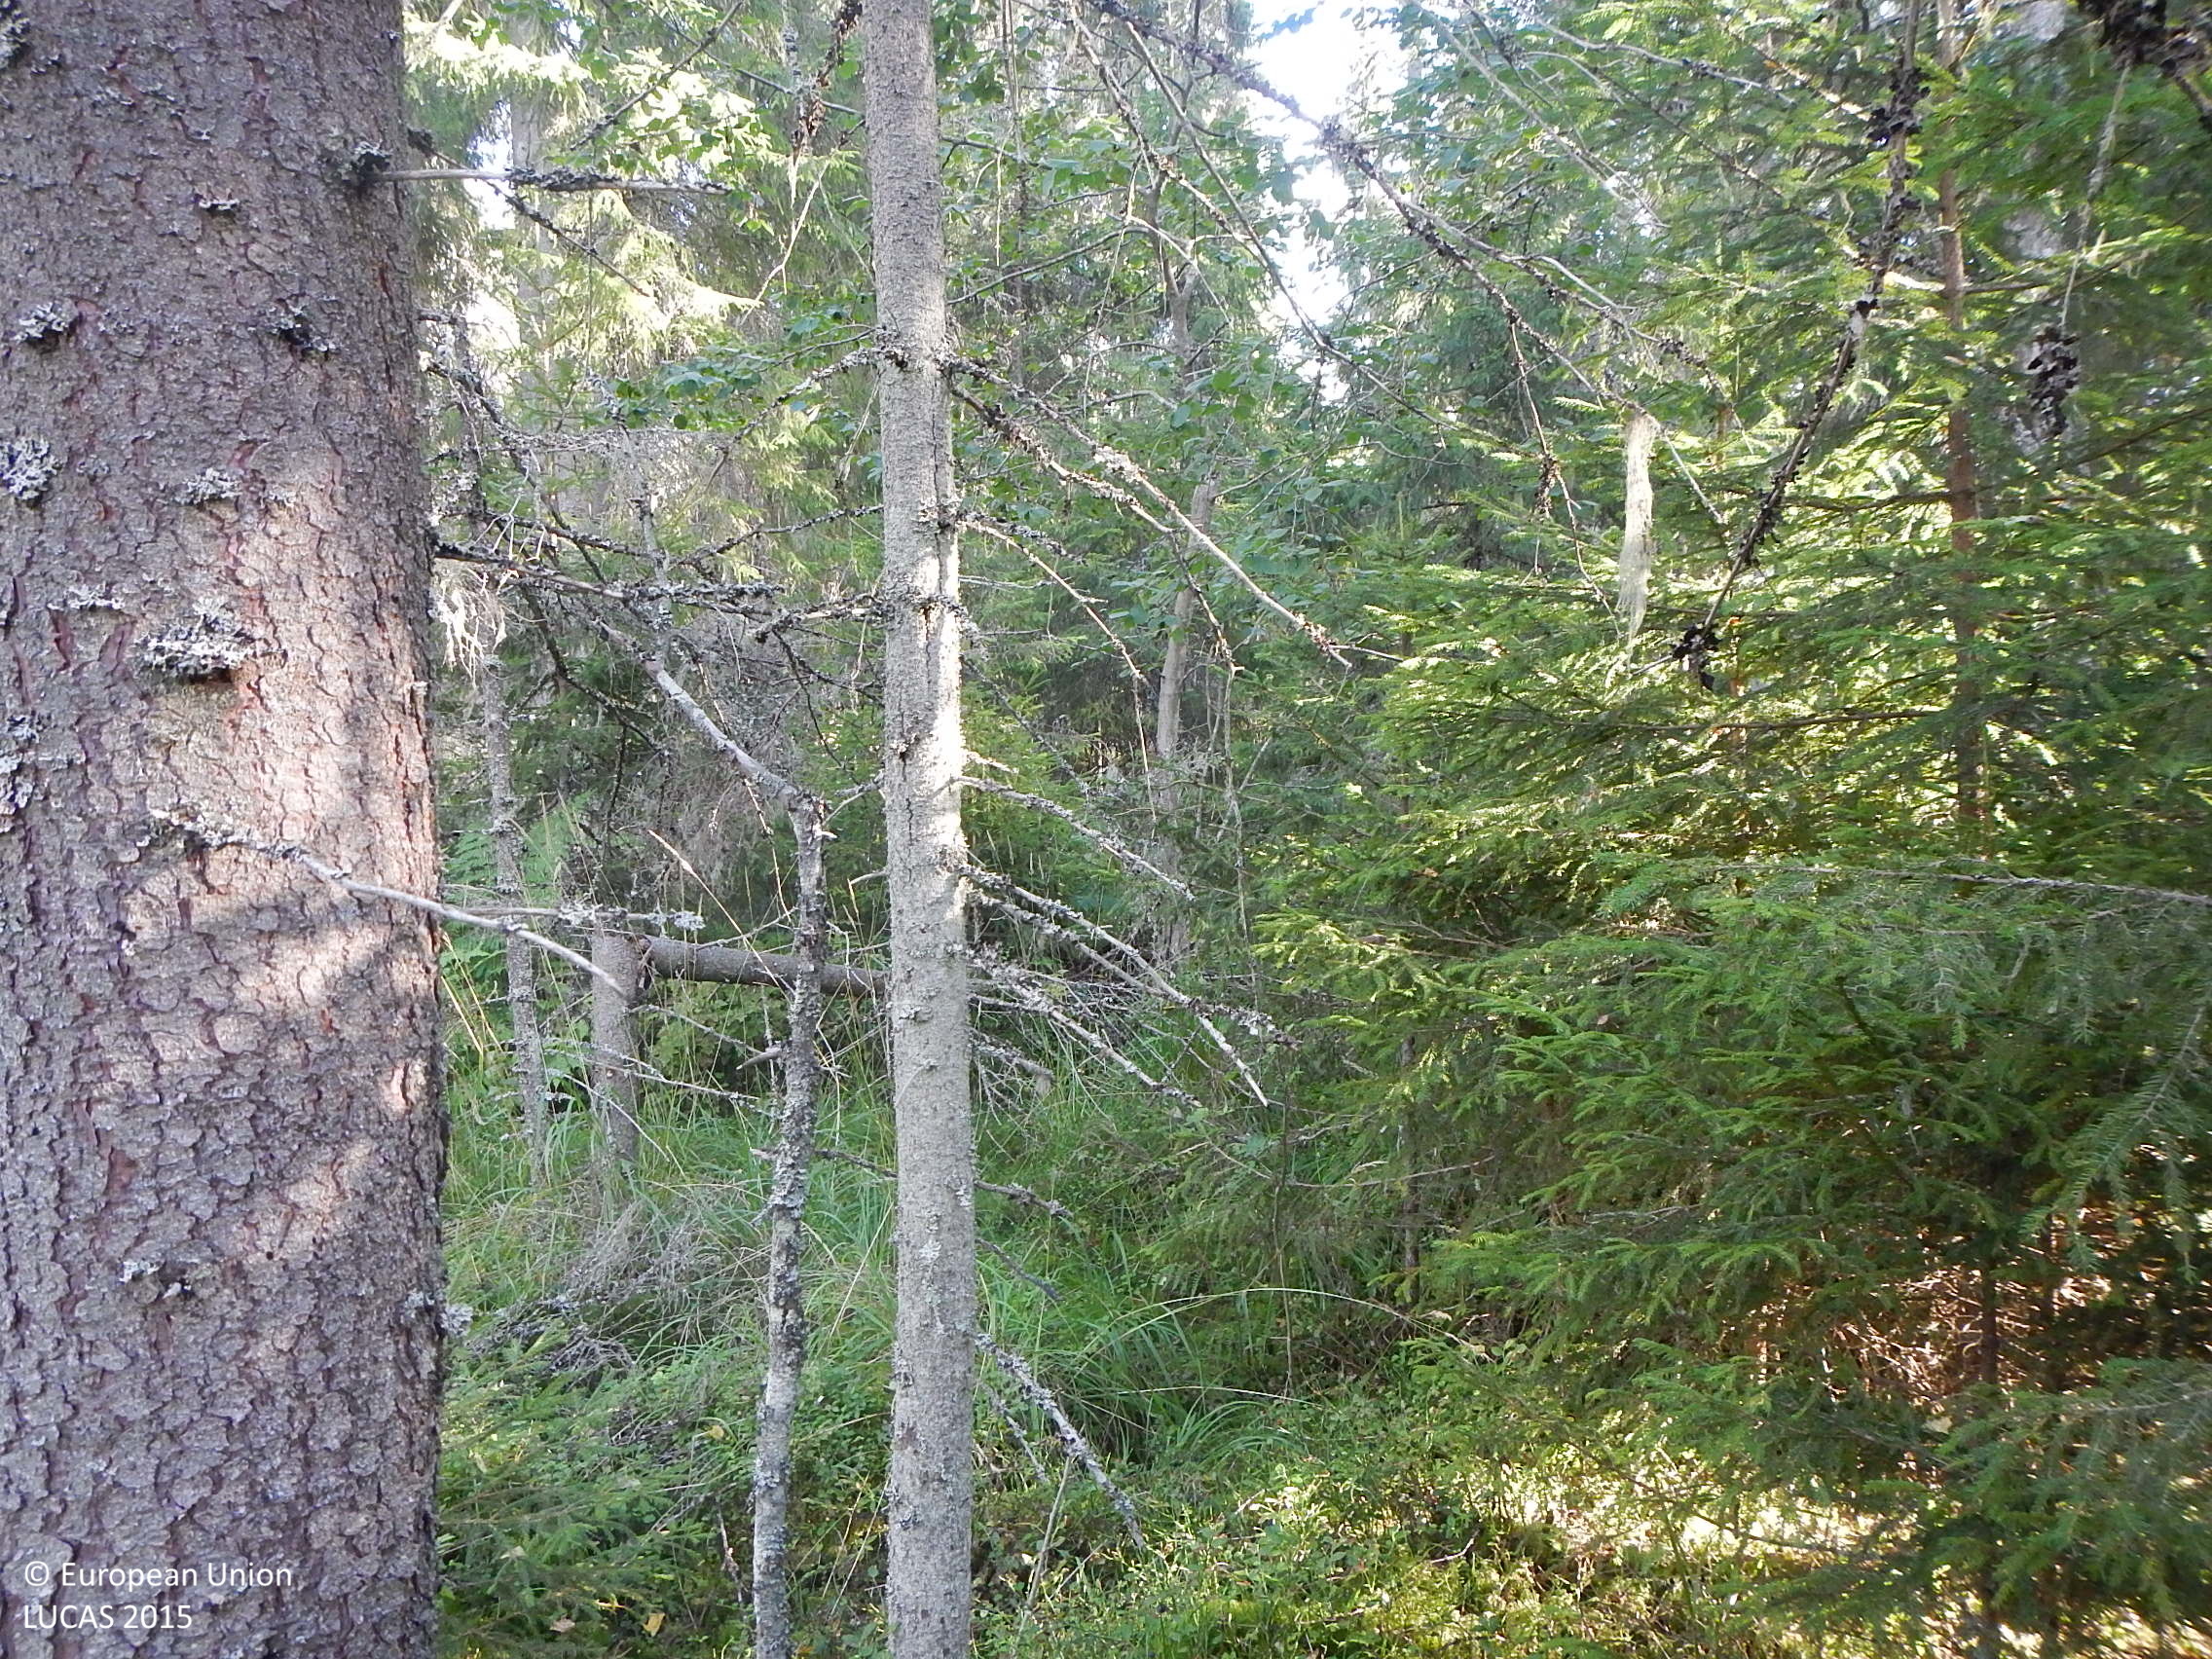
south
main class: Woodland
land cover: Spruce dominated coniferous woodland
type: boreal forest
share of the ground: > 75 %
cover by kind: coniferous forest trees 70 %, shrubs 20 %, broadleaved forest trees 10 %
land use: Forestry
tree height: > 5 m
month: September
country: FI
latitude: 61.4865
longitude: 22.0569
